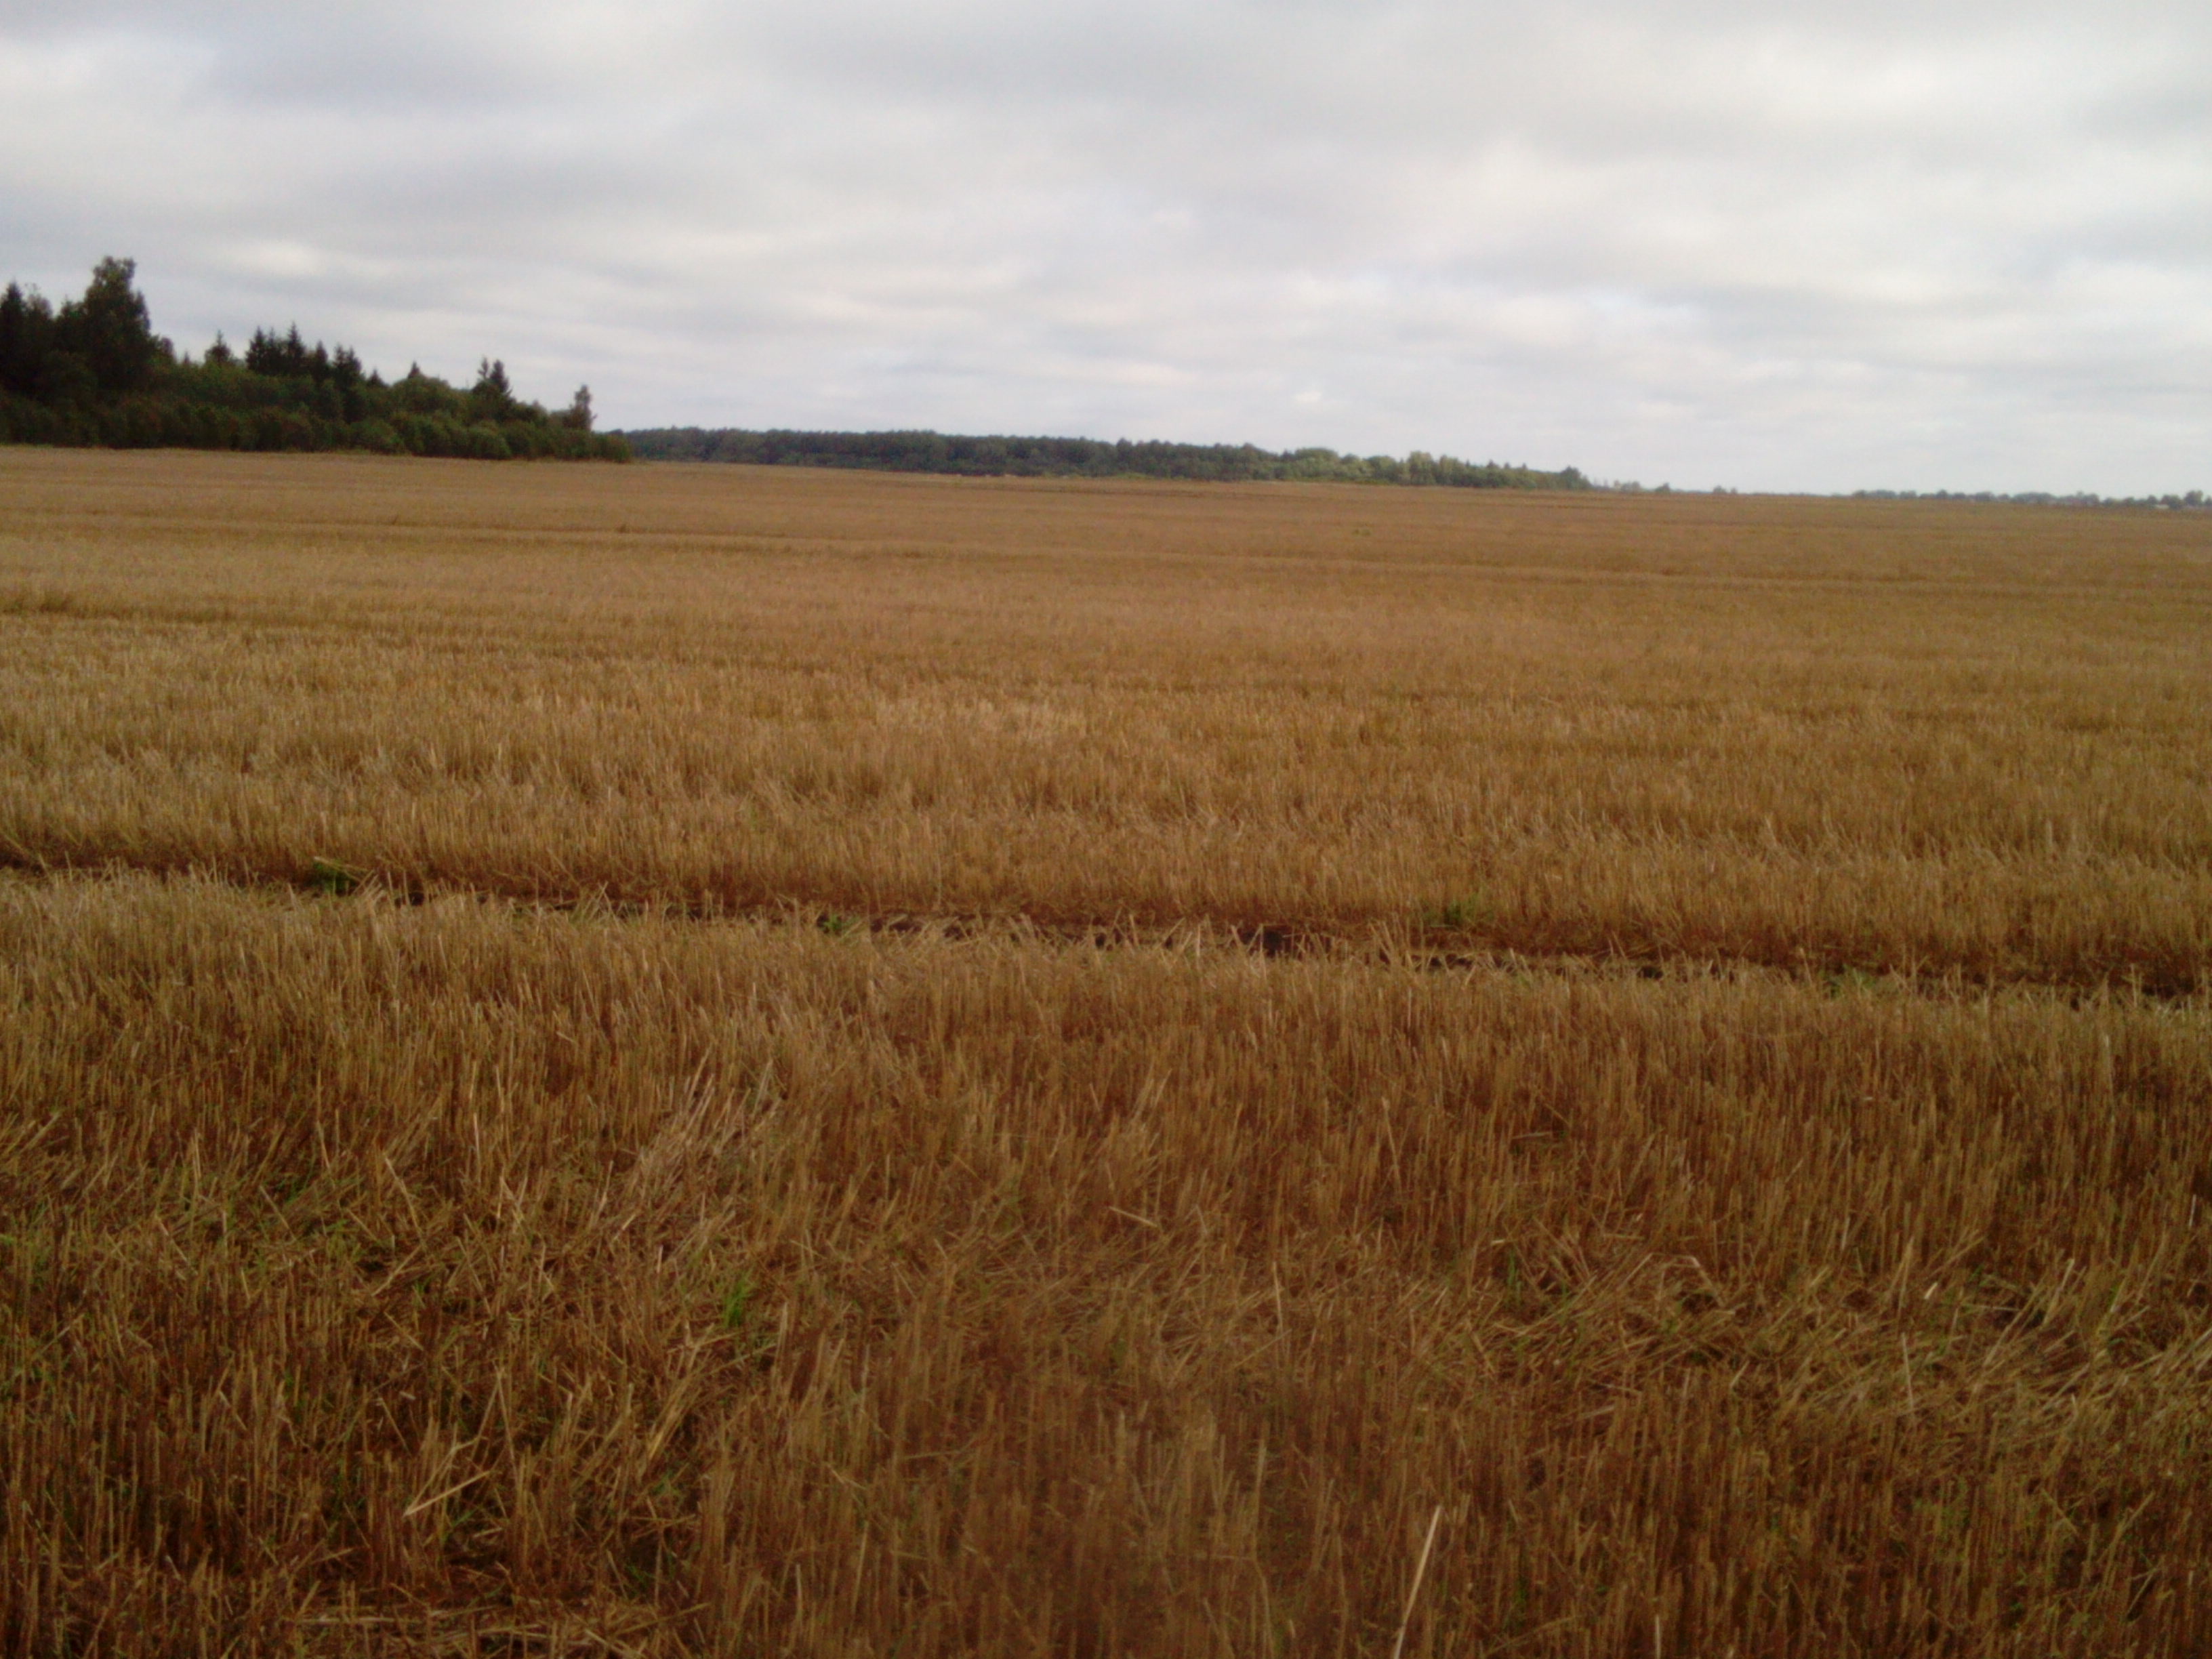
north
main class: Cropland
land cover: Common wheat
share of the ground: > 75 %
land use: Agriculture (excluding fallow land and kitchen gardens)
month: September
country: LT
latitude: 55.9531
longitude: 22.8944
